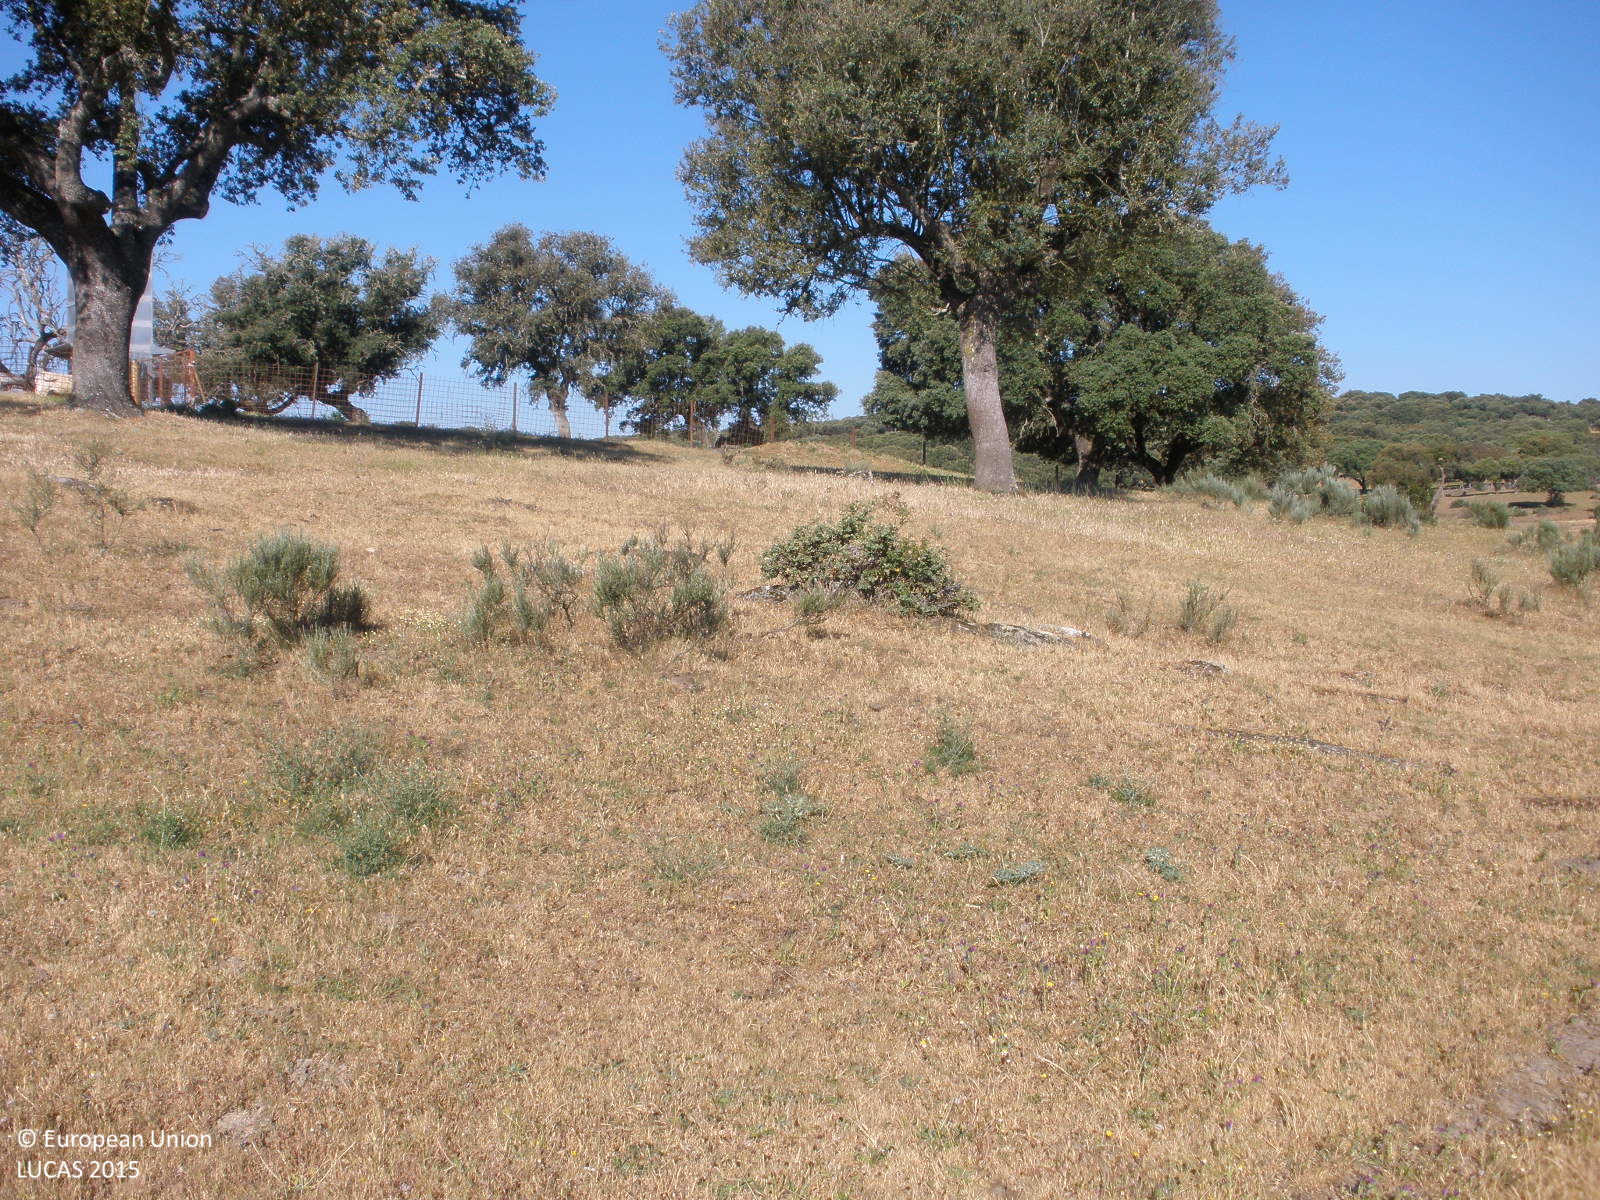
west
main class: Grassland
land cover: Grassland without tree/shrub cover
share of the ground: > 75 %
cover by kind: herbaceous plants 100 %
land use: Agriculture (excluding fallow land and kitchen gardens)
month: June
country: ES
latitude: 40.4572
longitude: -6.6344
